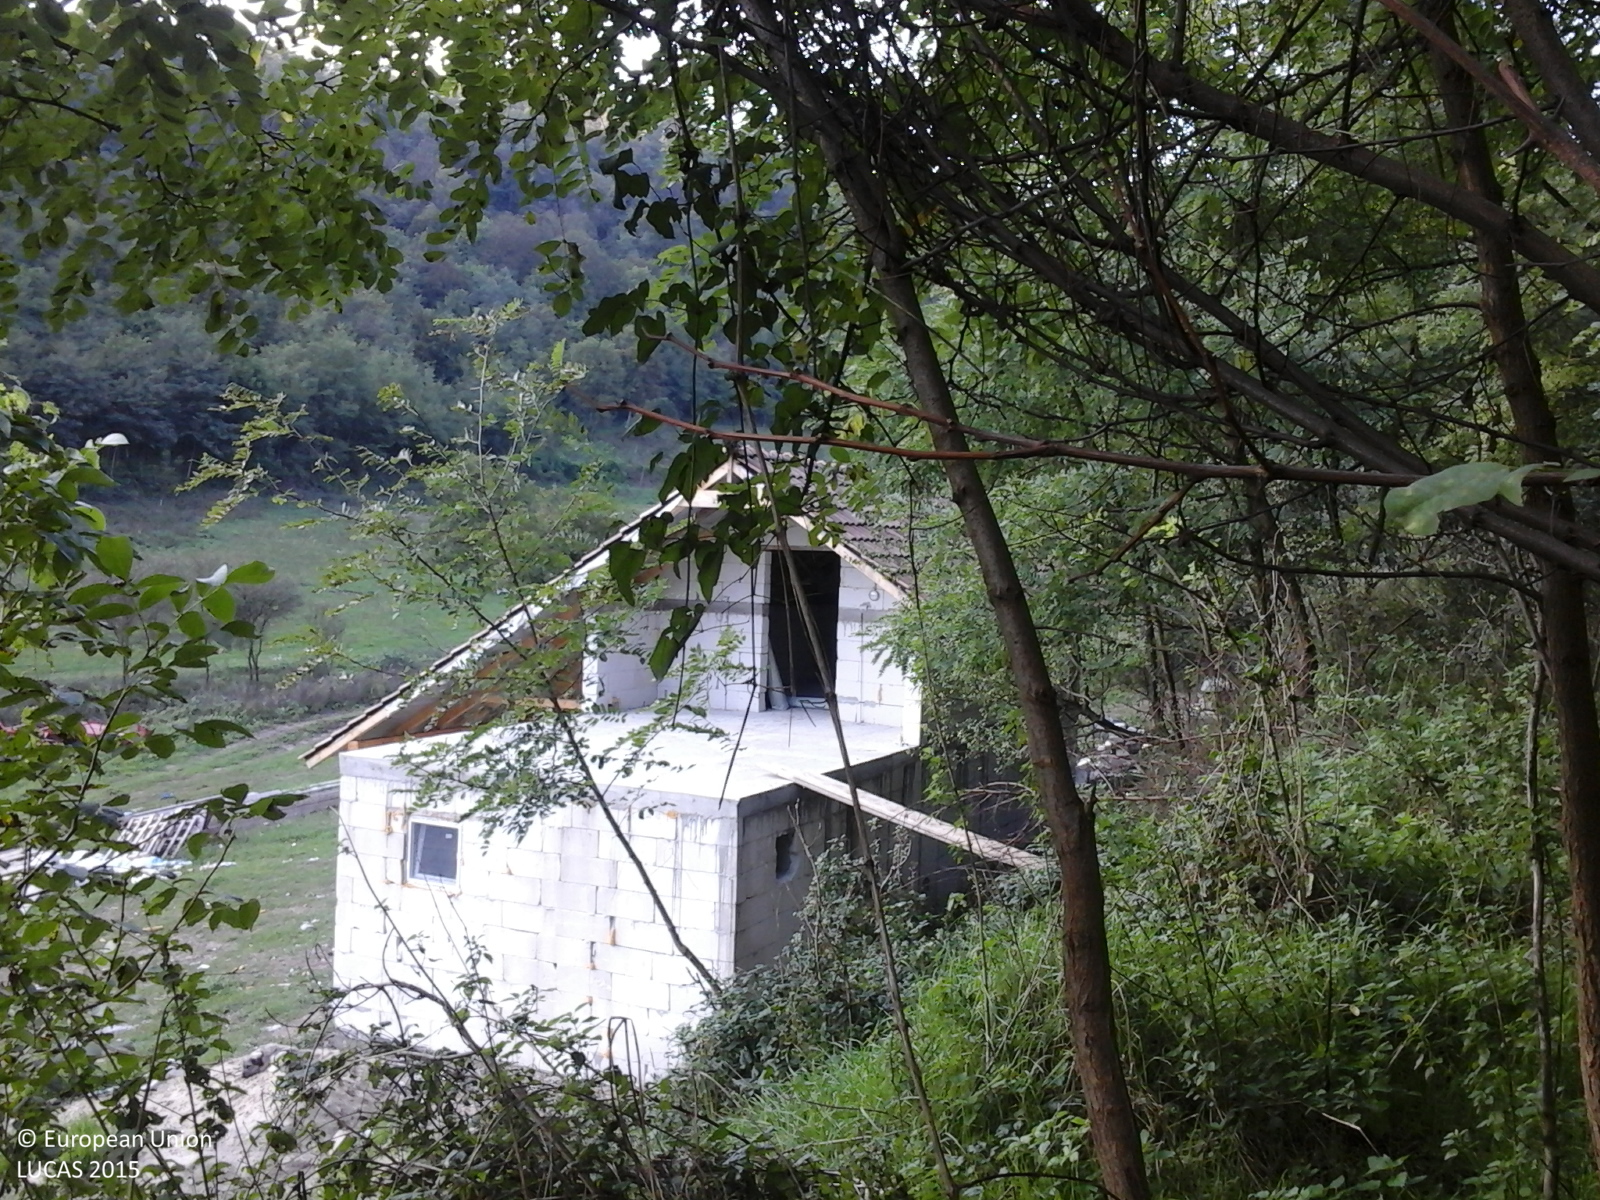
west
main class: Woodland
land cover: Broadleaved woodland
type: exotic forest
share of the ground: > 75 %
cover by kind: broadleaved forest trees 100 %
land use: Forestry
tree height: > 5 m
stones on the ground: < 10 %
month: October
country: RO
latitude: 46.0763
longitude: 24.1844
